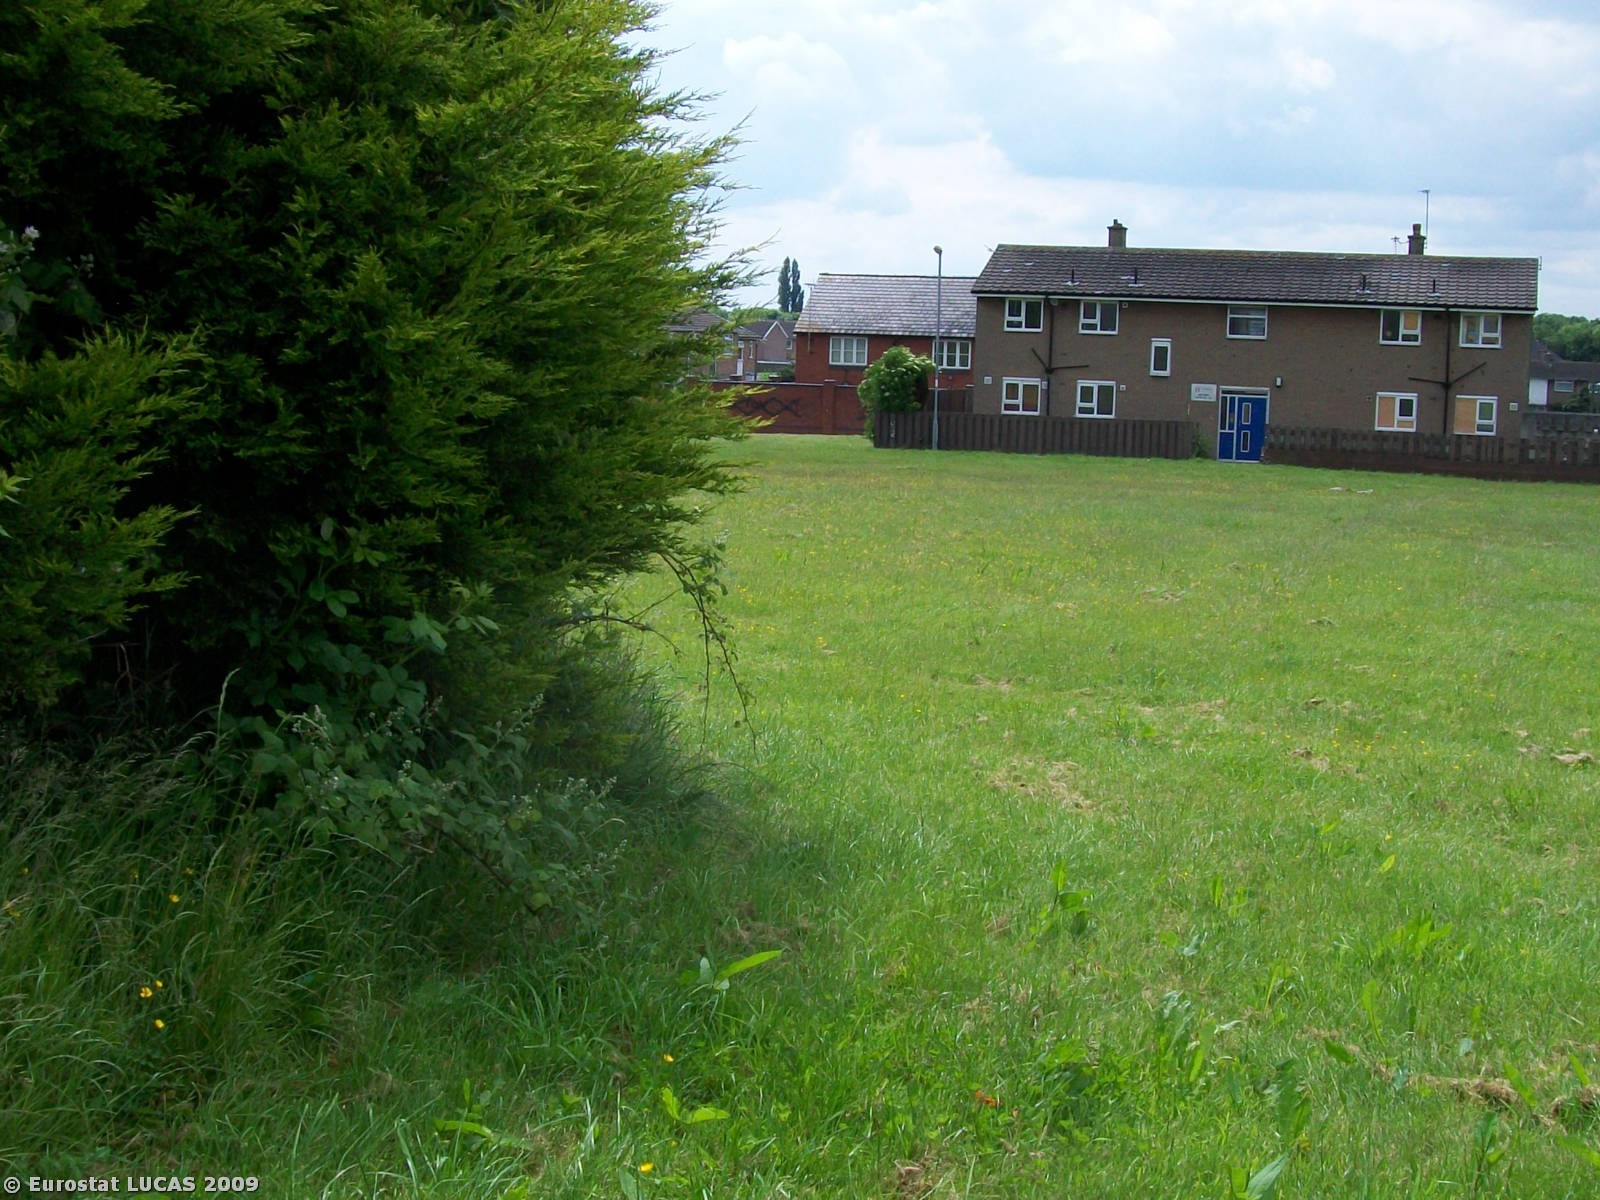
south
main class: Grassland
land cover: Grassland without tree/shrub cover
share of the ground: < 10 %
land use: Amenities, museums, leisure
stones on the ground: < 10 %
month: June
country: GB
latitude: 53.3777
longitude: -2.7725
